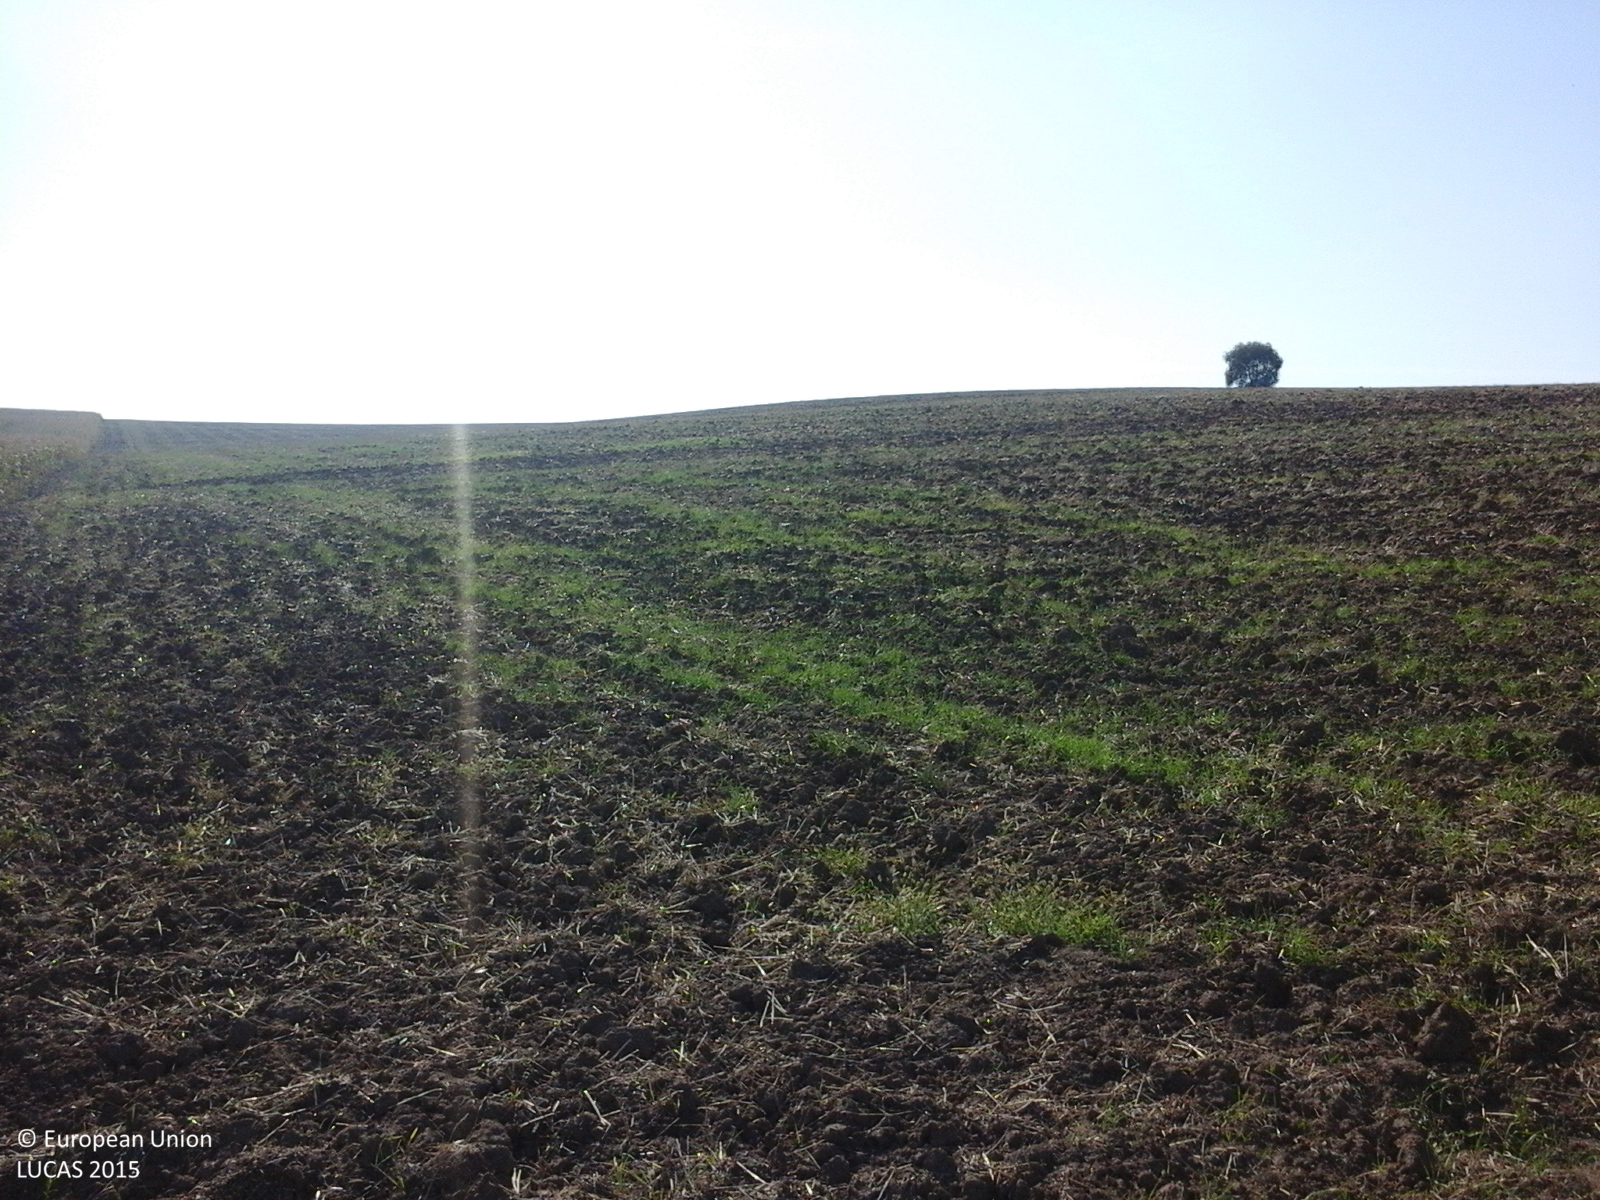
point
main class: Grassland
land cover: Spontaneously vegetated surfaces
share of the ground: 10 - 25 %
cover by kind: herbaceous plants 100 %
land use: Fallow land
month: September
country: RO
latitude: 47.2899
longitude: 22.6596
